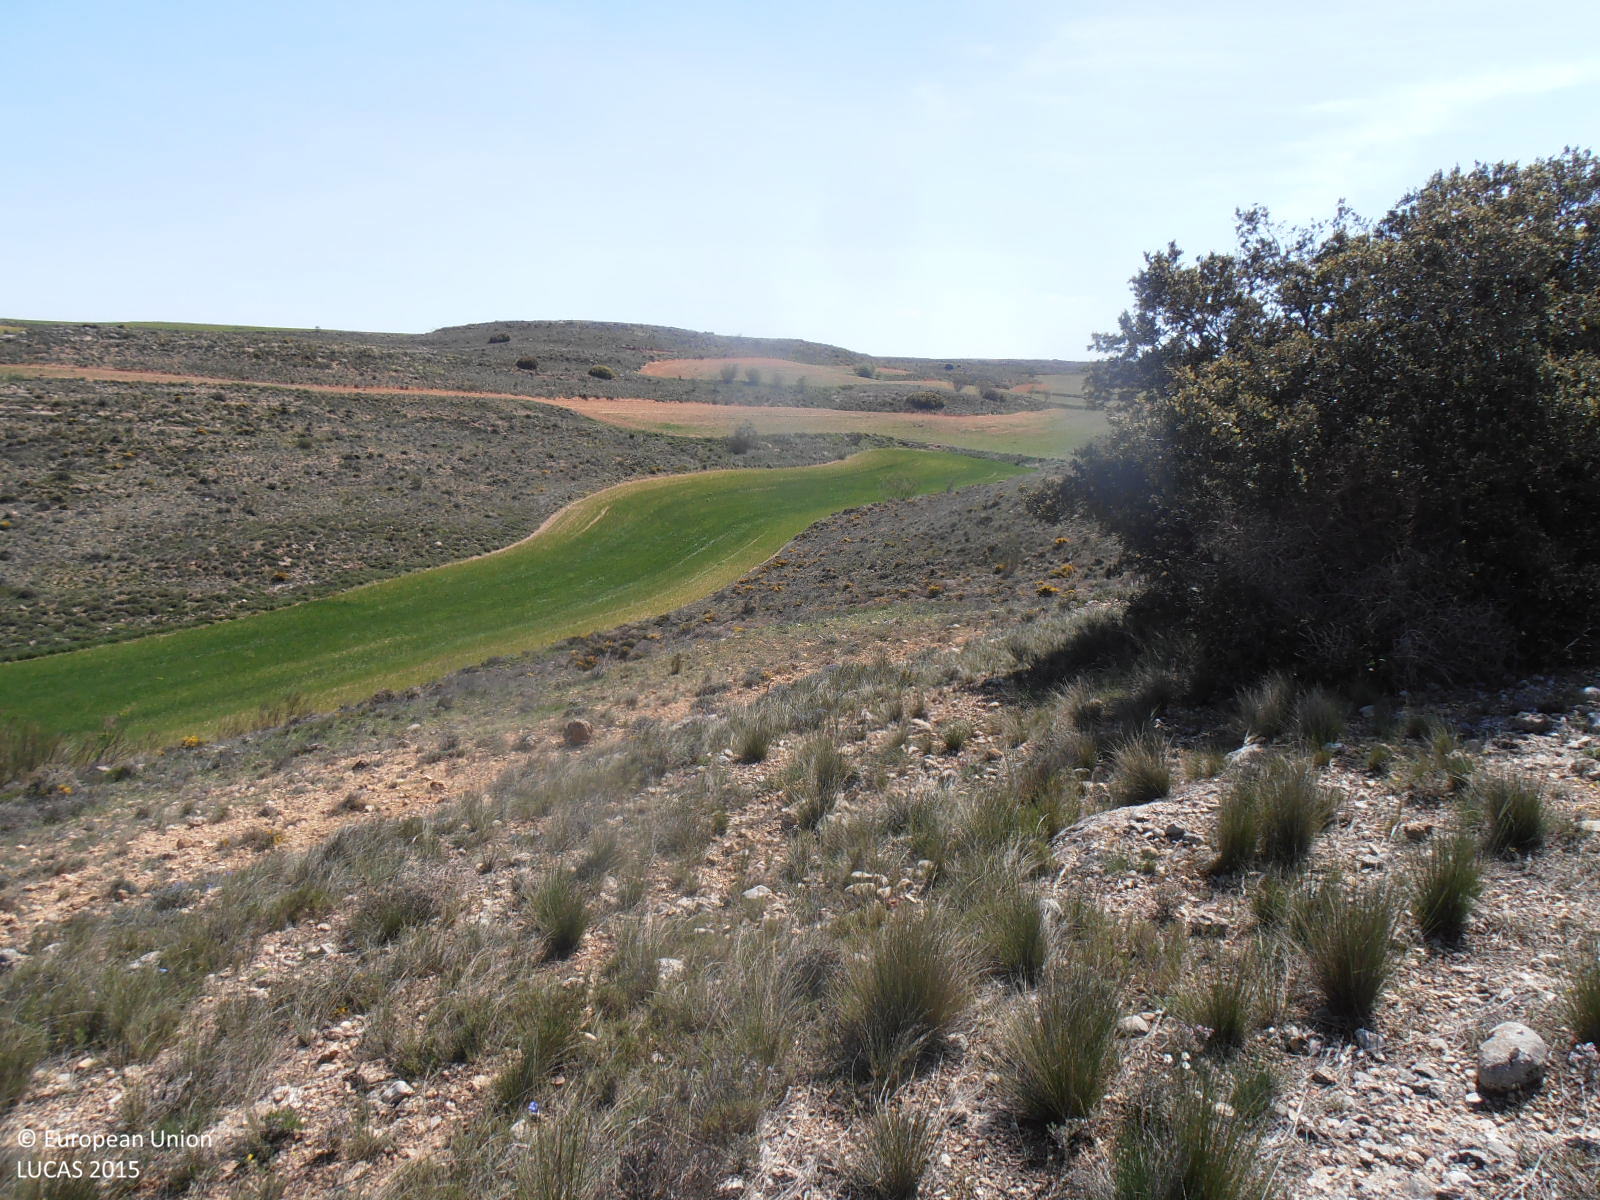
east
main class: Shrubland
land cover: Shrubland without tree cover
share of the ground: 50 - 75 %
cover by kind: shrubs 60 %, consolidated bare surface 30 %, herbaceous plants 10 %
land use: Semi-natural and natural areas not in use
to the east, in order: Shrubland without tree cover; Barley; Shrubland without tree cover; Spontaneously vegetated surfaces; Shrubland without tree cover; Spontaneously vegetated surfaces
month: April
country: ES
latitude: 41.2046
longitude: -0.9297
